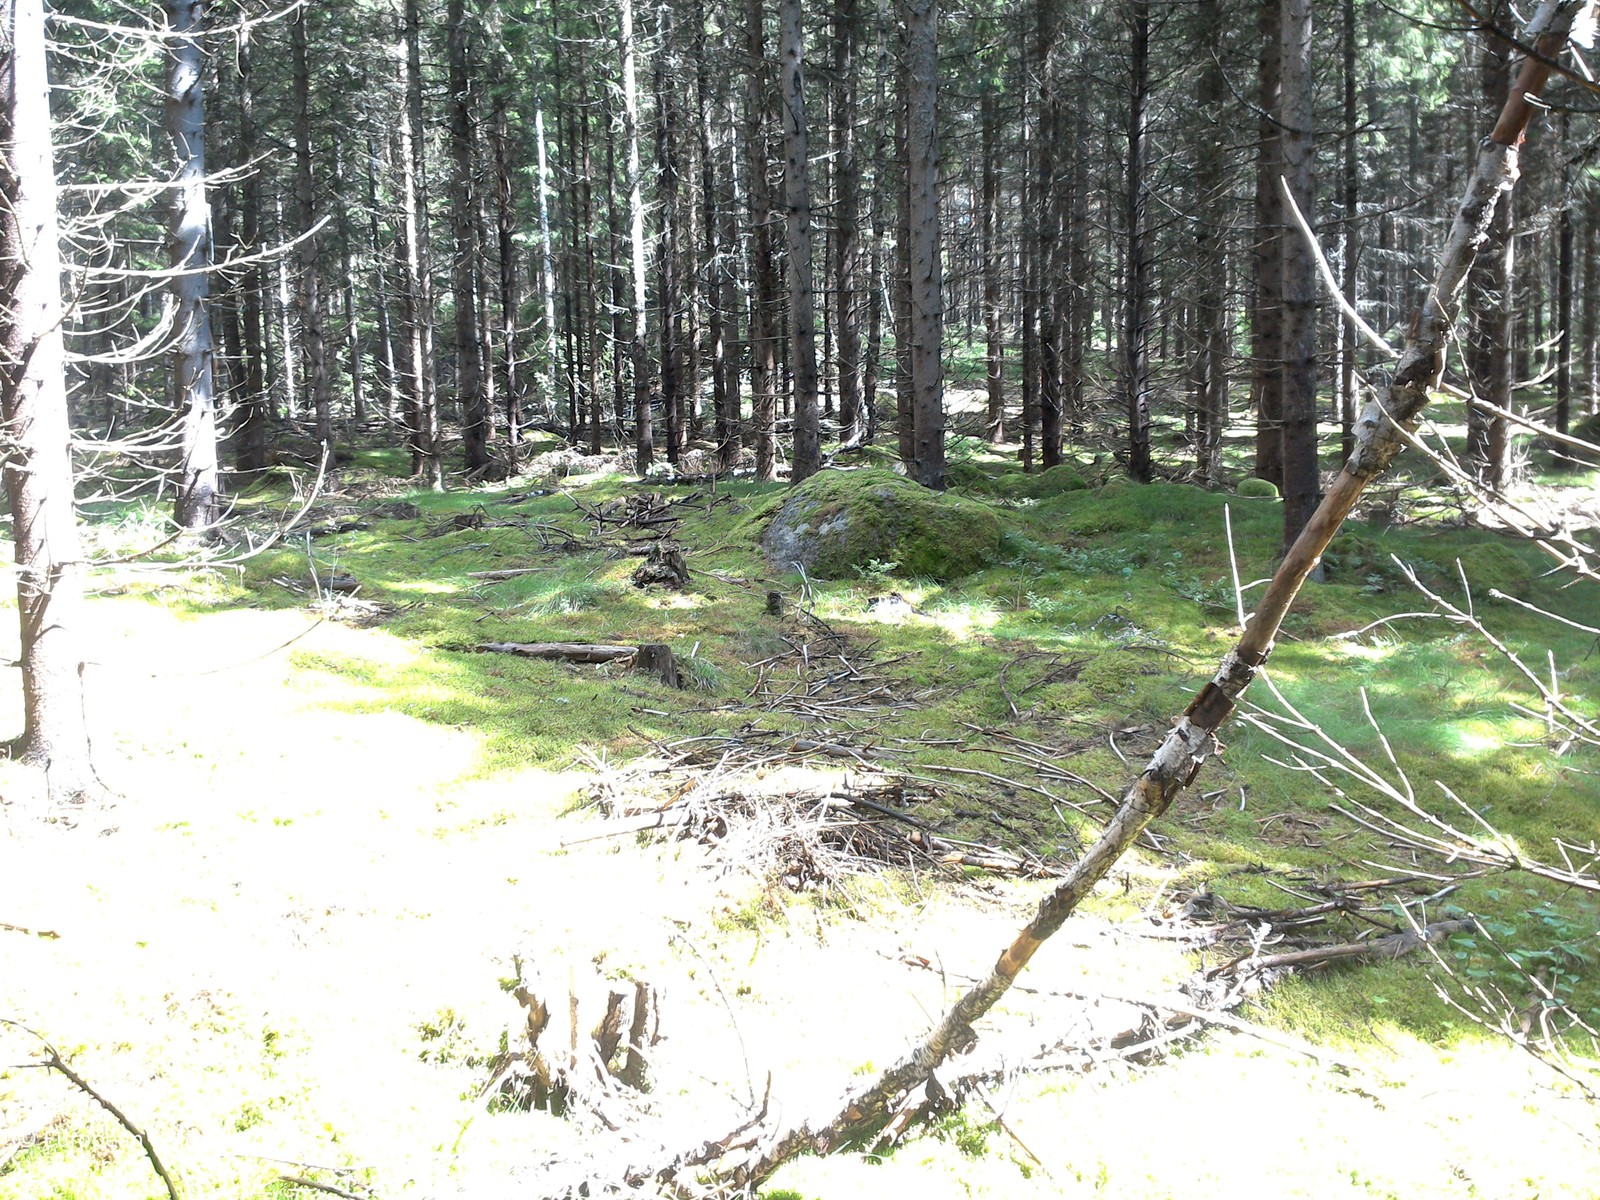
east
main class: Woodland
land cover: Spruce dominated coniferous woodland
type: boreal forest
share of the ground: > 75 %
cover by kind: coniferous forest trees 75 %, lichens and mosses 25 %
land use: Forestry
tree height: > 5 m
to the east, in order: Spruce dominated coniferous woodland; Pine dominated coniferous woodland; Paved roads, cycling and walking lanes; Pine dominated coniferous woodland; Spruce dominated coniferous woodland; Tracks; Spruce dominated coniferous woodland
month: July
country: SE
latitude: 58.5965
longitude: 14.9661
